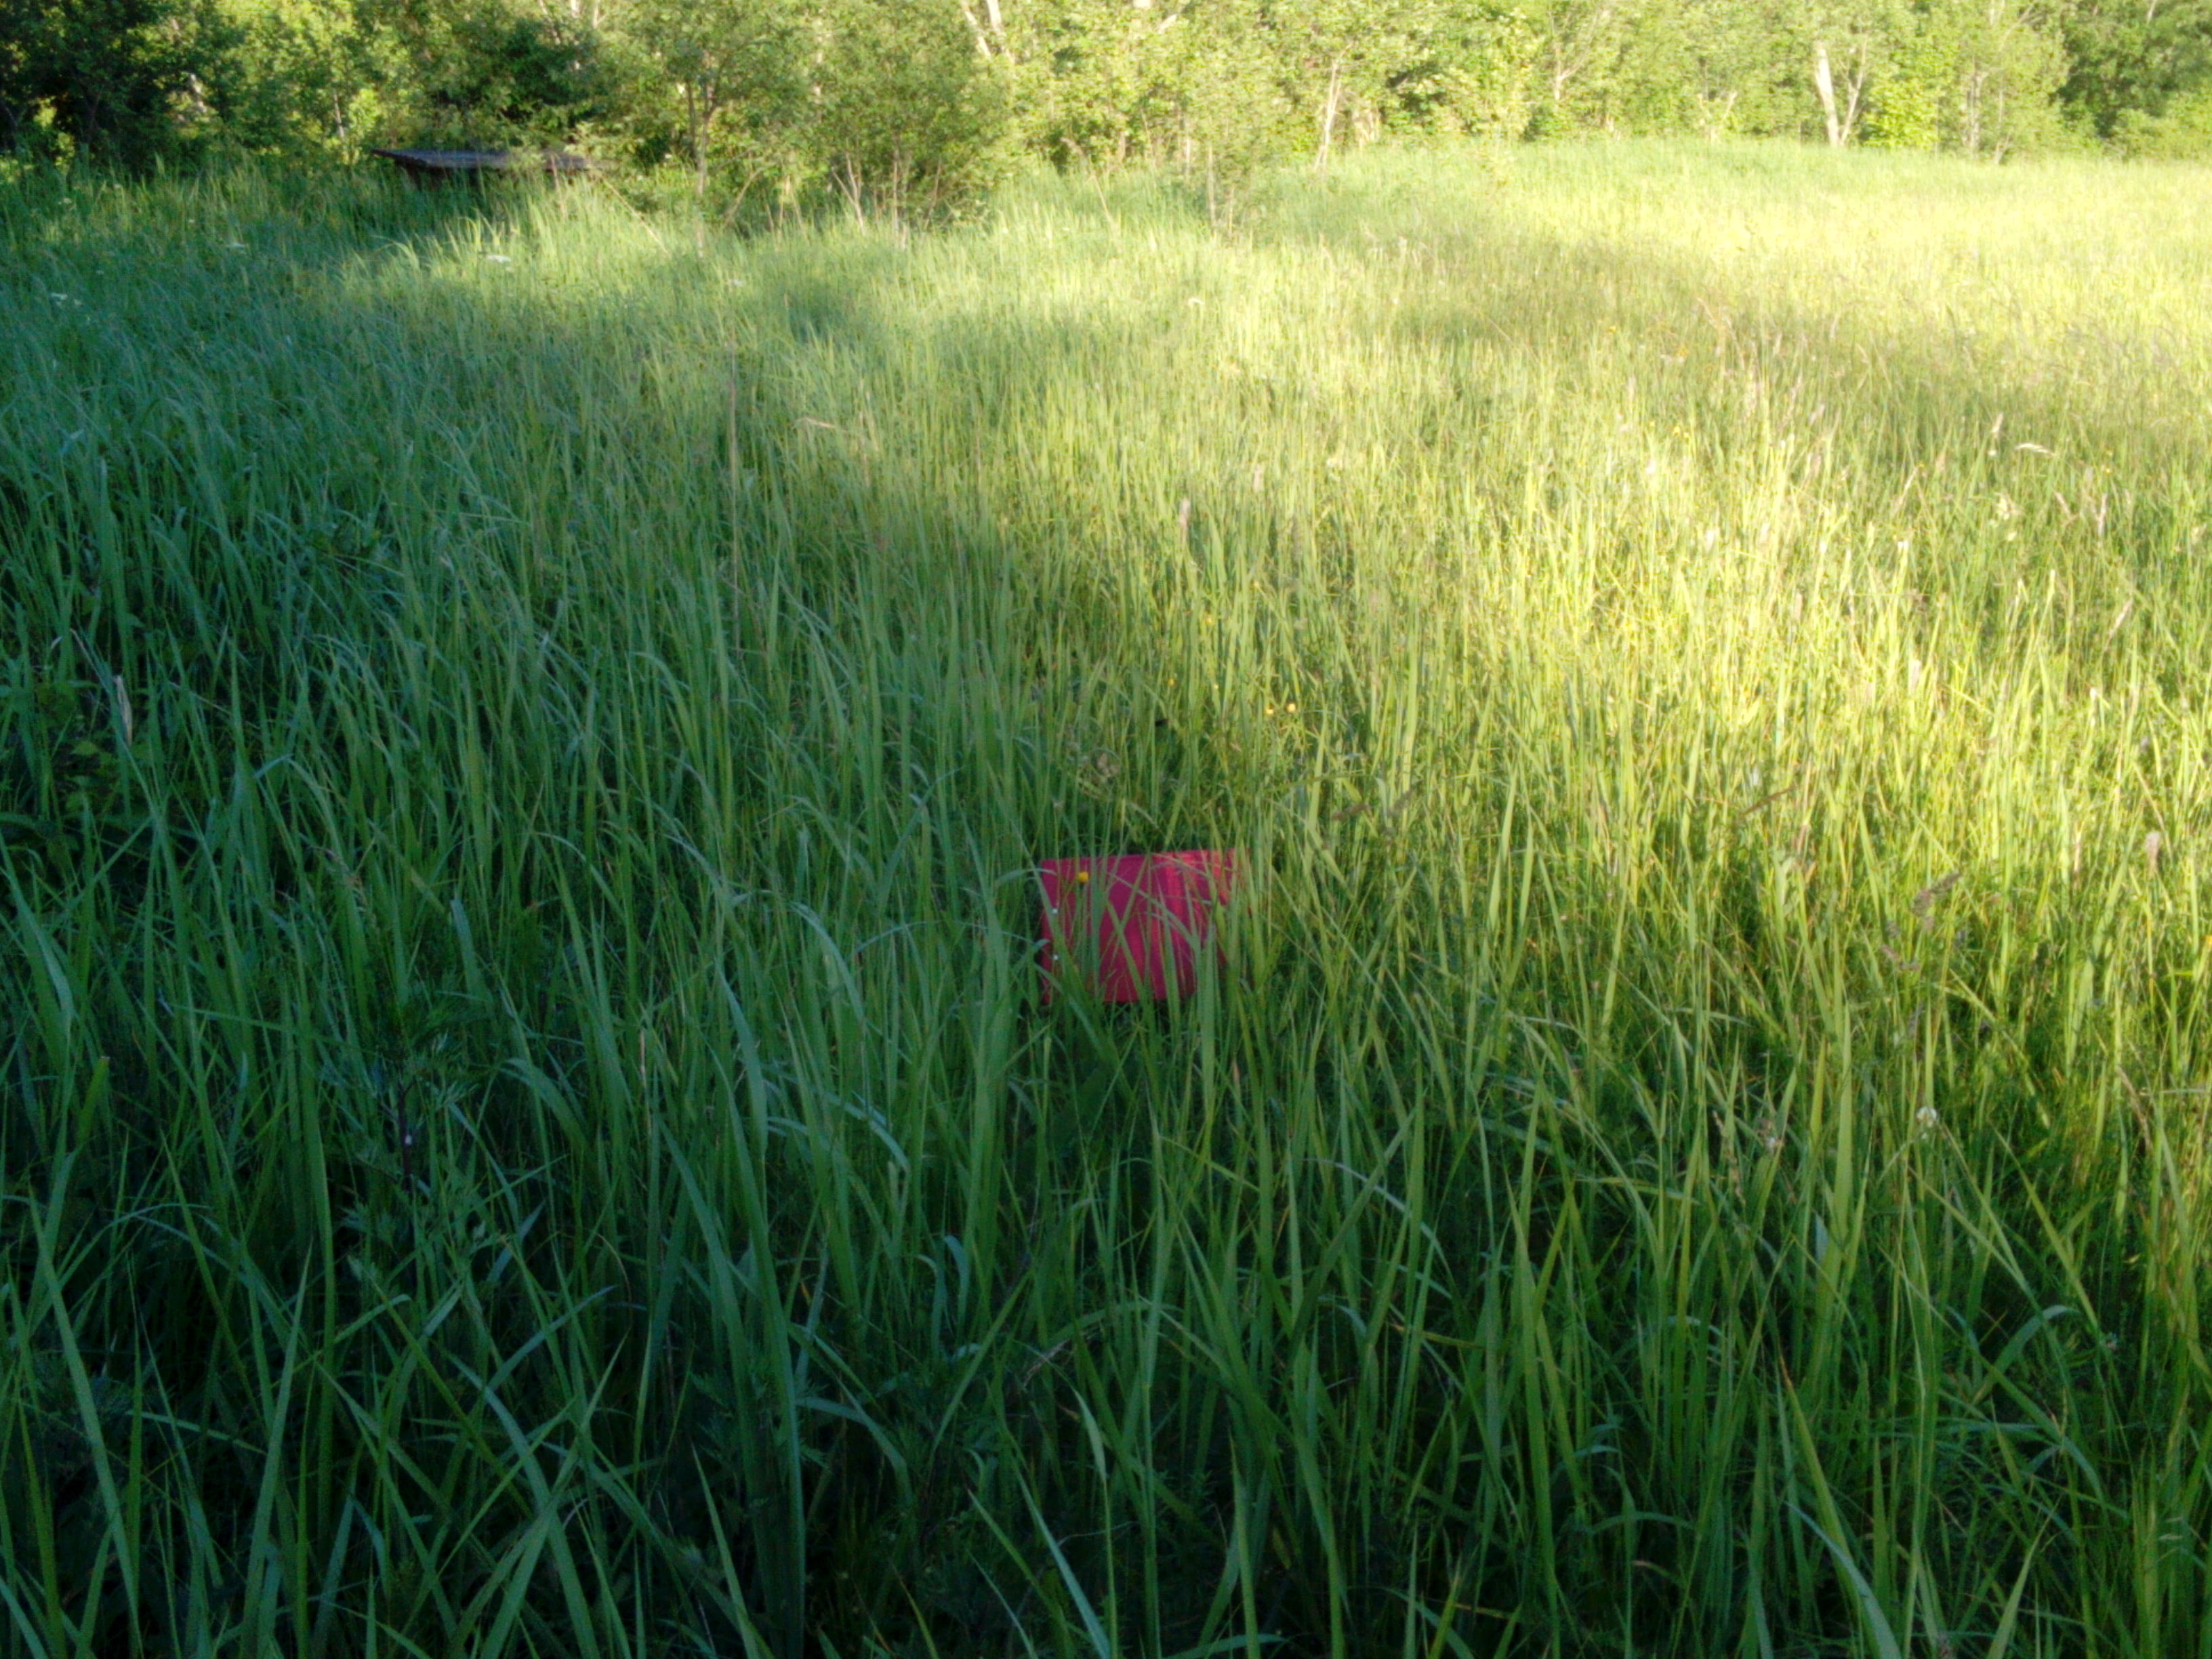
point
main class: Grassland
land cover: Grassland without tree/shrub cover
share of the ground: > 75 %
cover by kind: herbaceous plants 100 %
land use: Agriculture (excluding fallow land and kitchen gardens)
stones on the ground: < 10 %
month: June
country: LV
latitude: 56.6854
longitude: 22.1146
